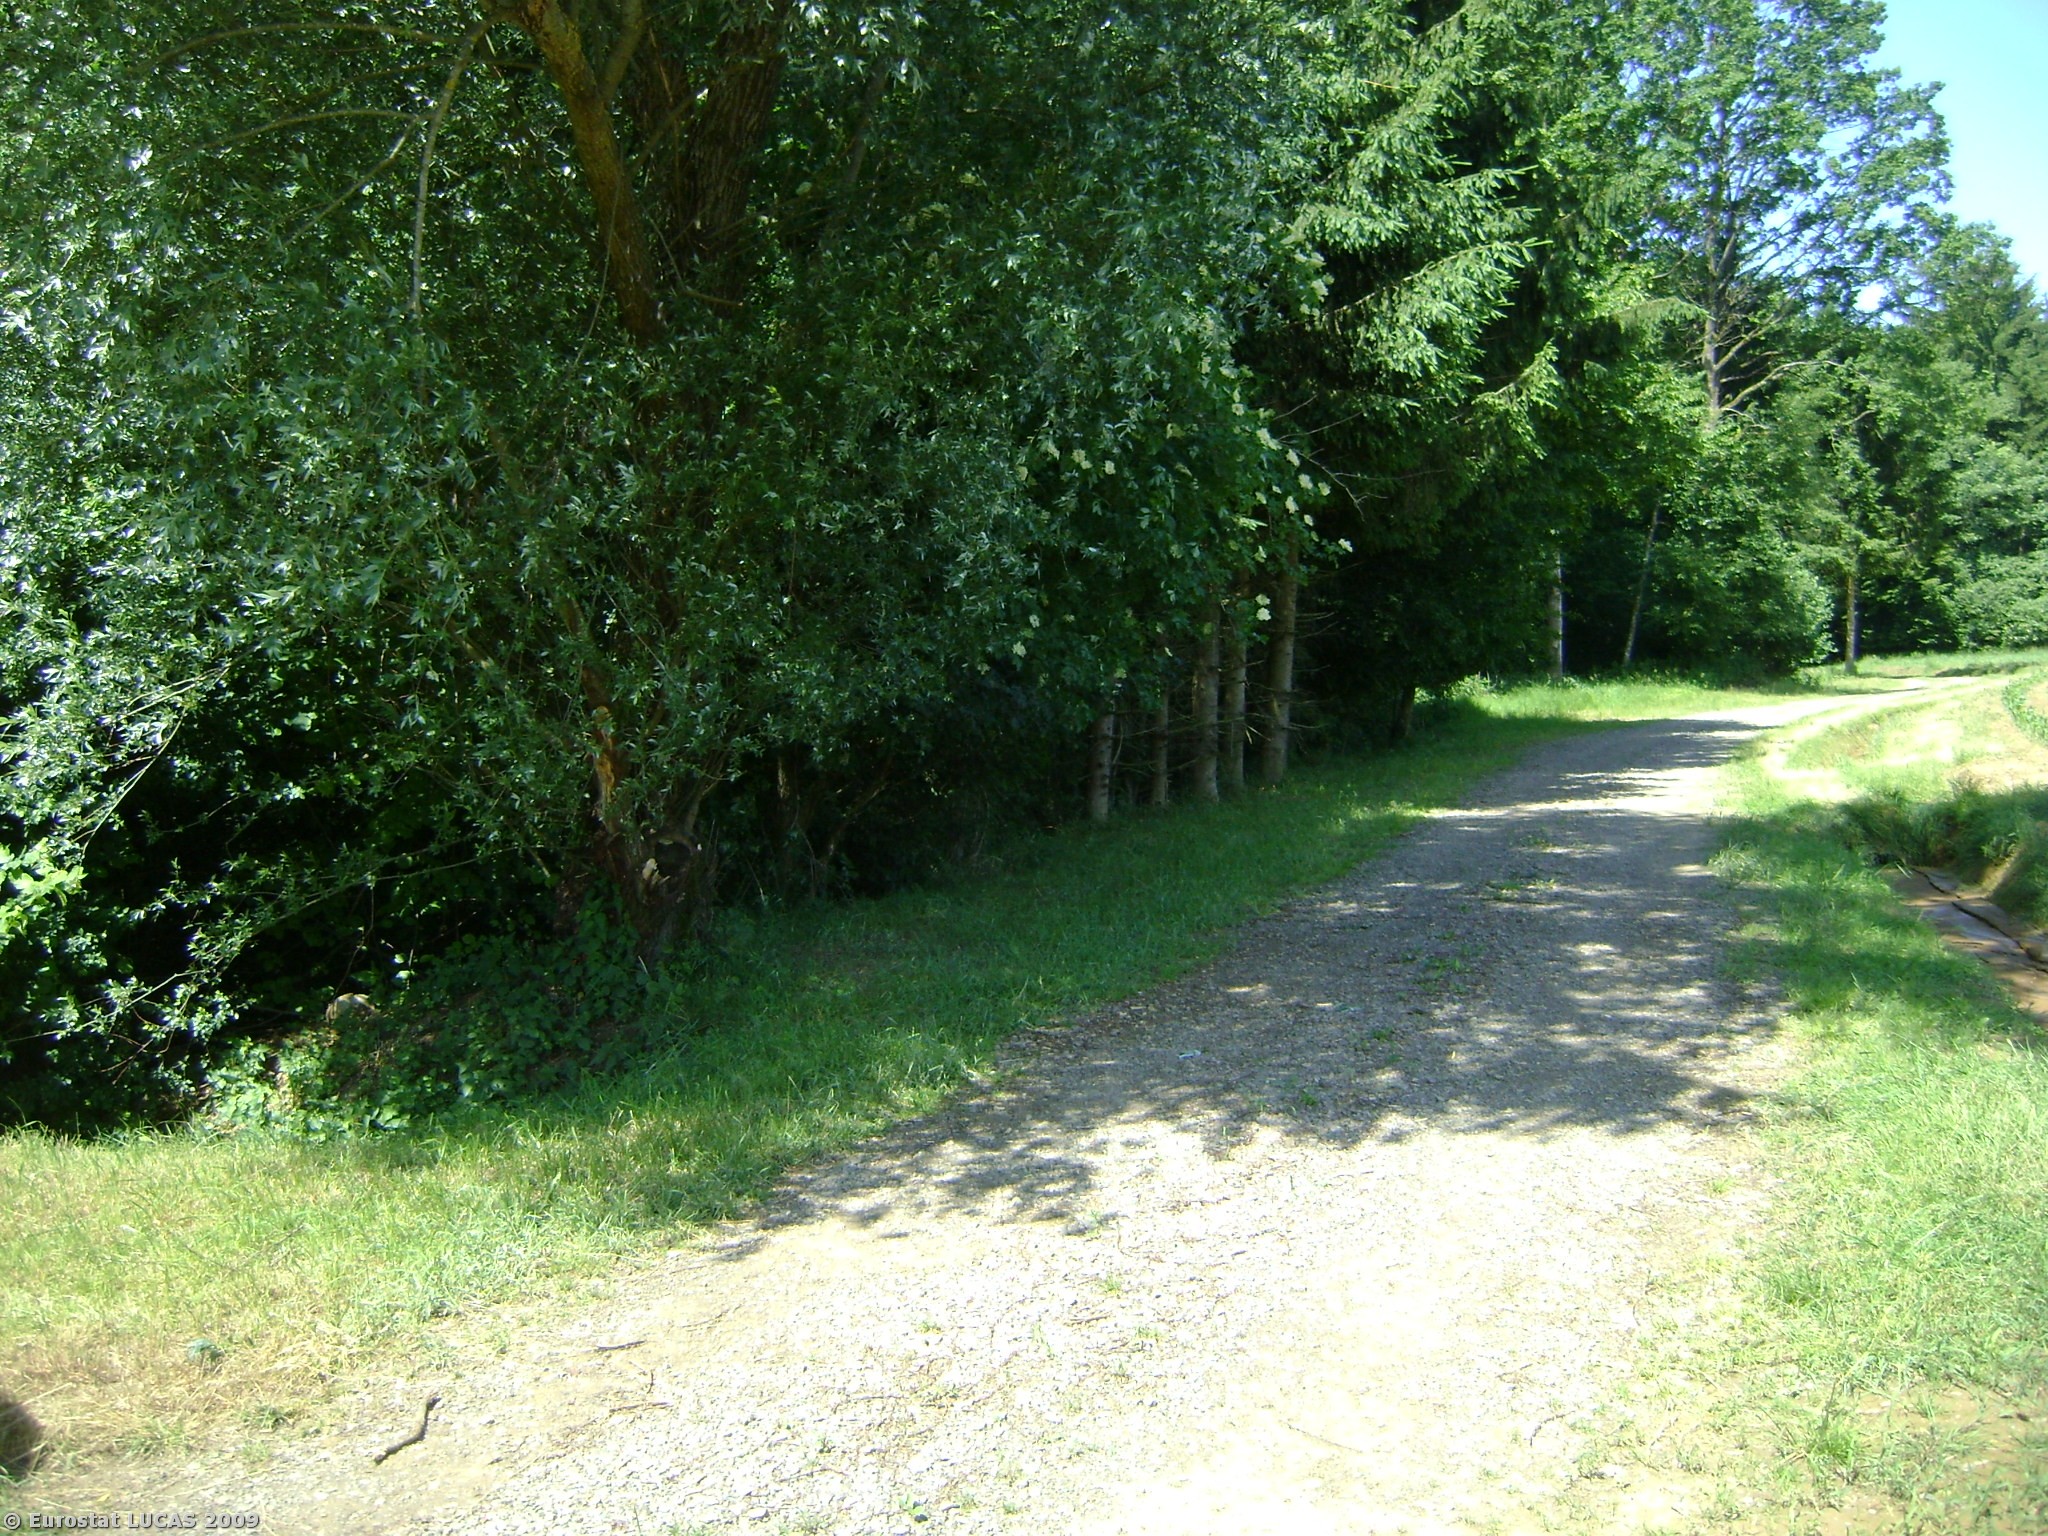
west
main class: Cropland
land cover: Maize
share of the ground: 25 - 50 %
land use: Agriculture (excluding fallow land and kitchen gardens)
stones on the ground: < 10 %
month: May
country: AT
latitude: 46.8130
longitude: 15.7007
